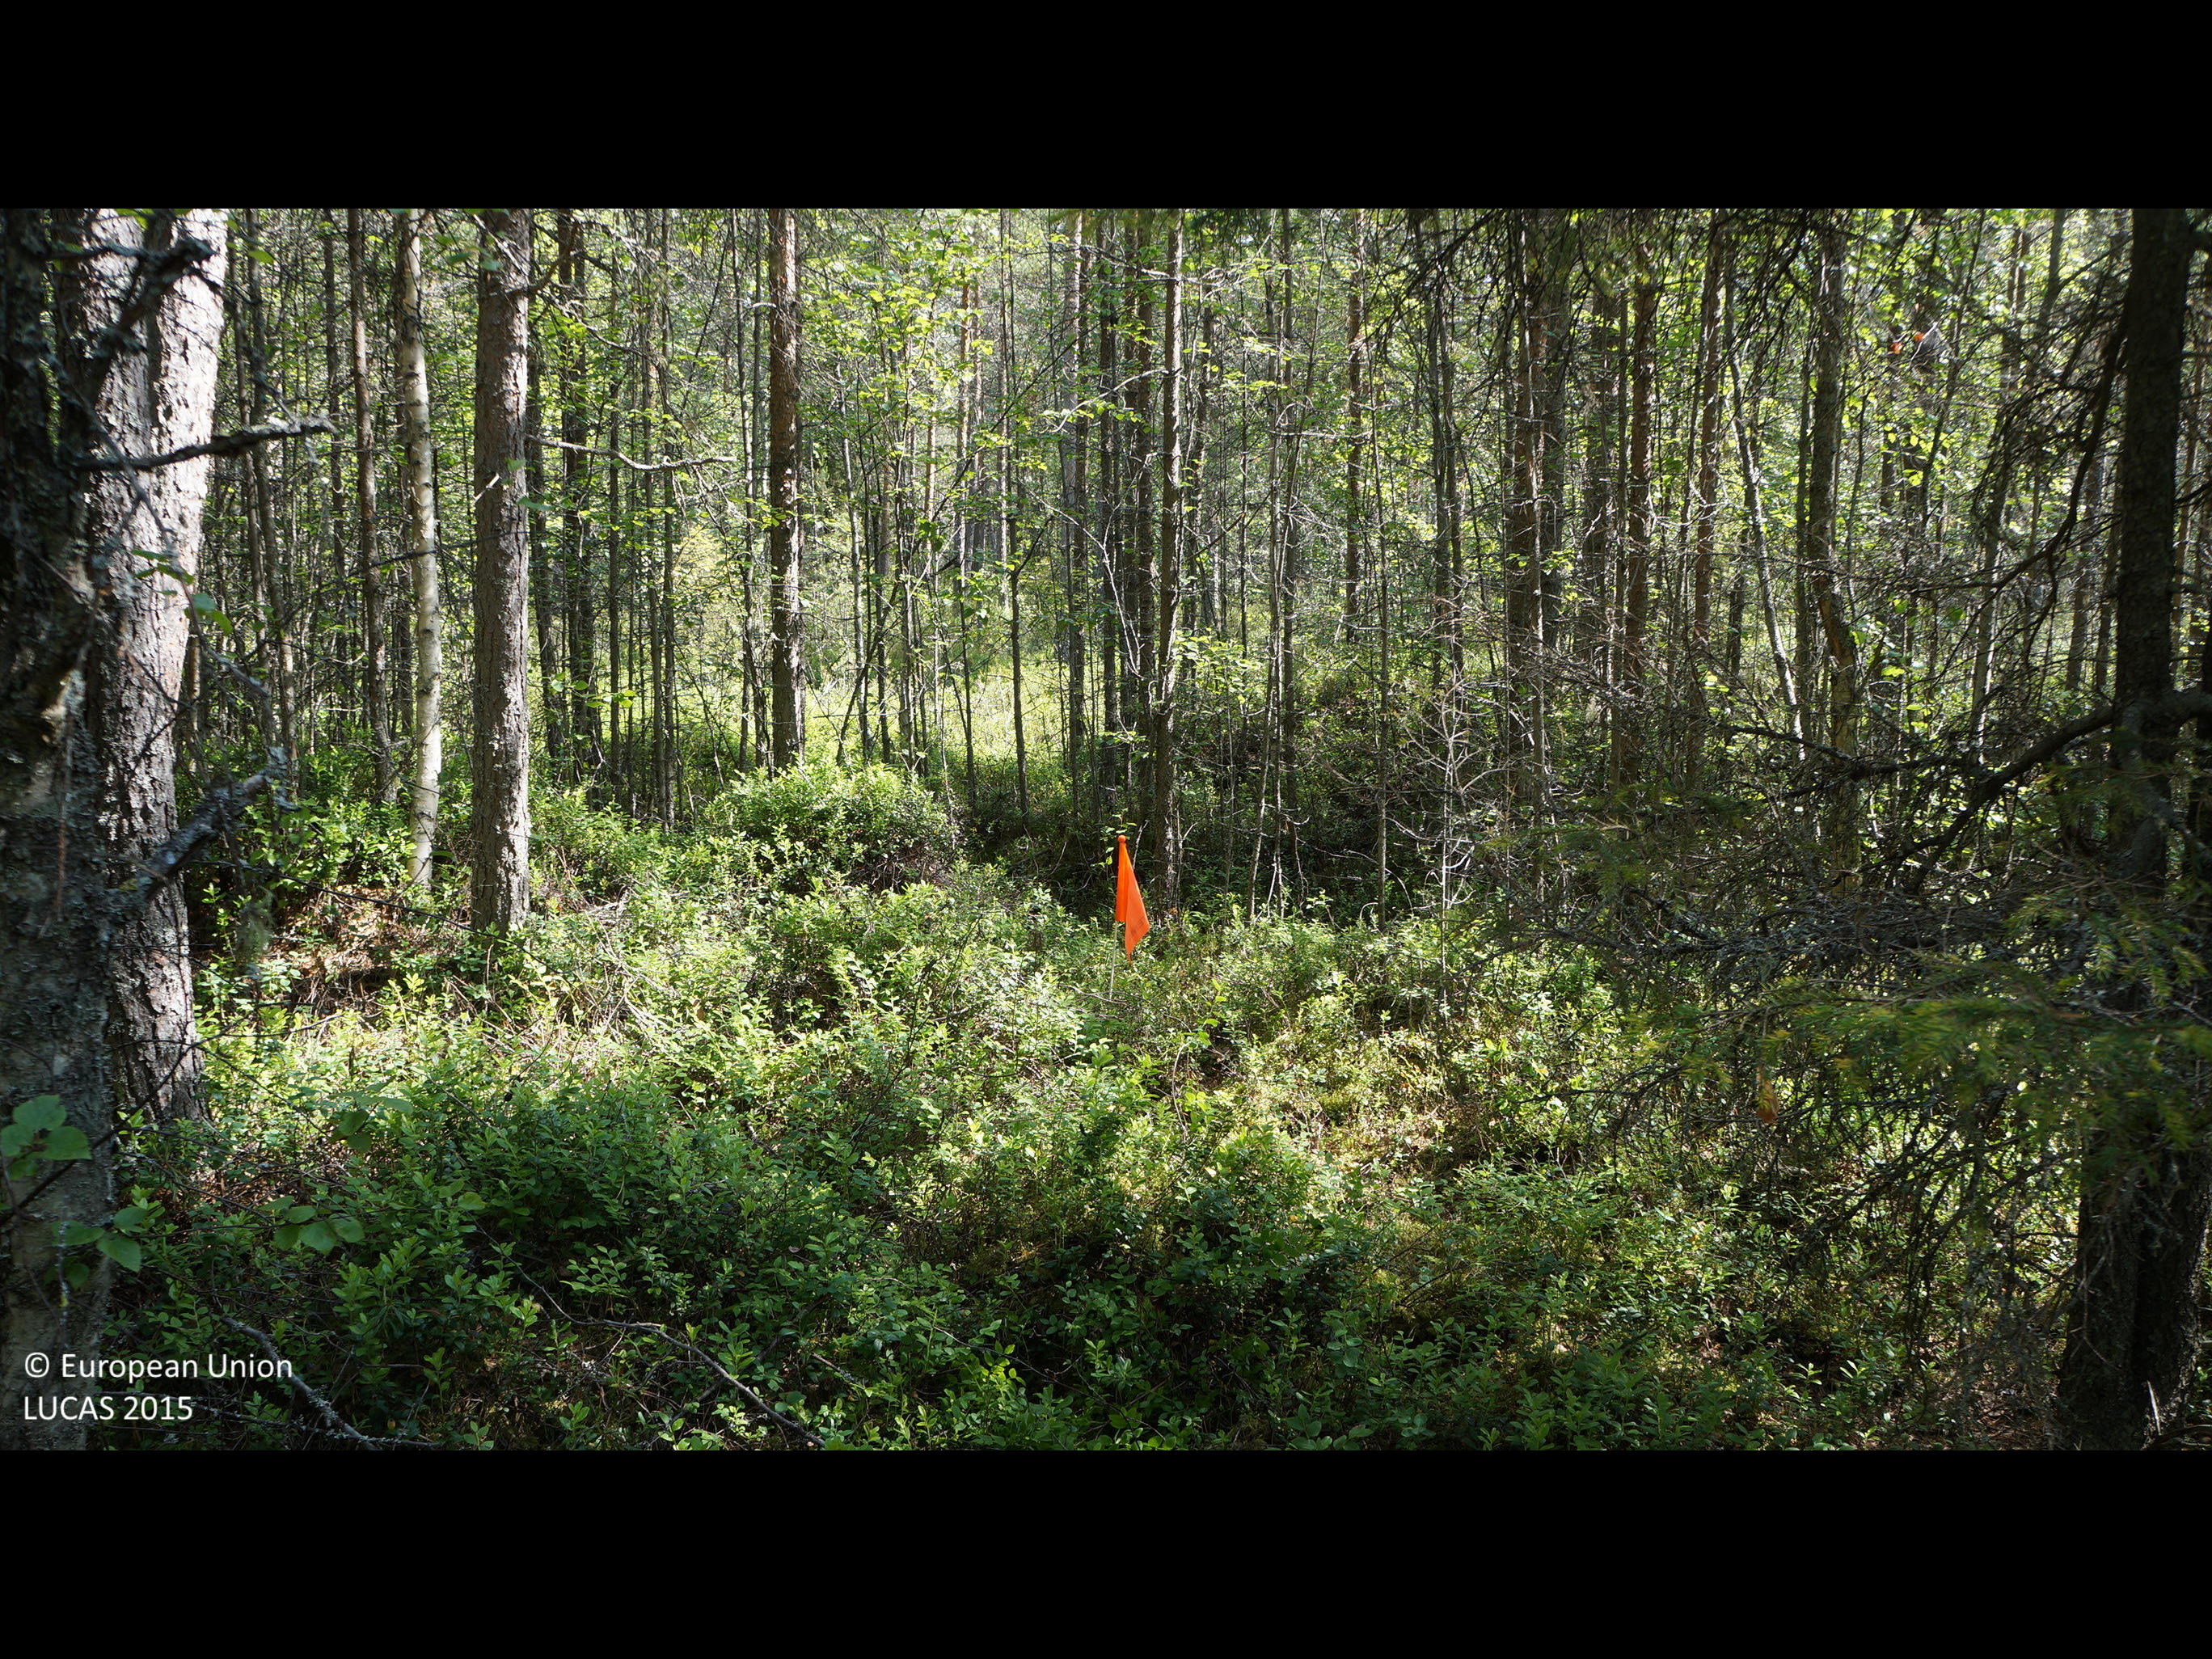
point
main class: Woodland
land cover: Pine dominated coniferous woodland
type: boreal forest
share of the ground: 50 - 75 %
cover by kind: coniferous forest trees 60 %, shrubs 25 %, broadleaved forest trees 10 %, lichens and mosses 5 %
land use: Forestry
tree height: > 5 m
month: July
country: FI
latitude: 64.5657
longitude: 24.4033
